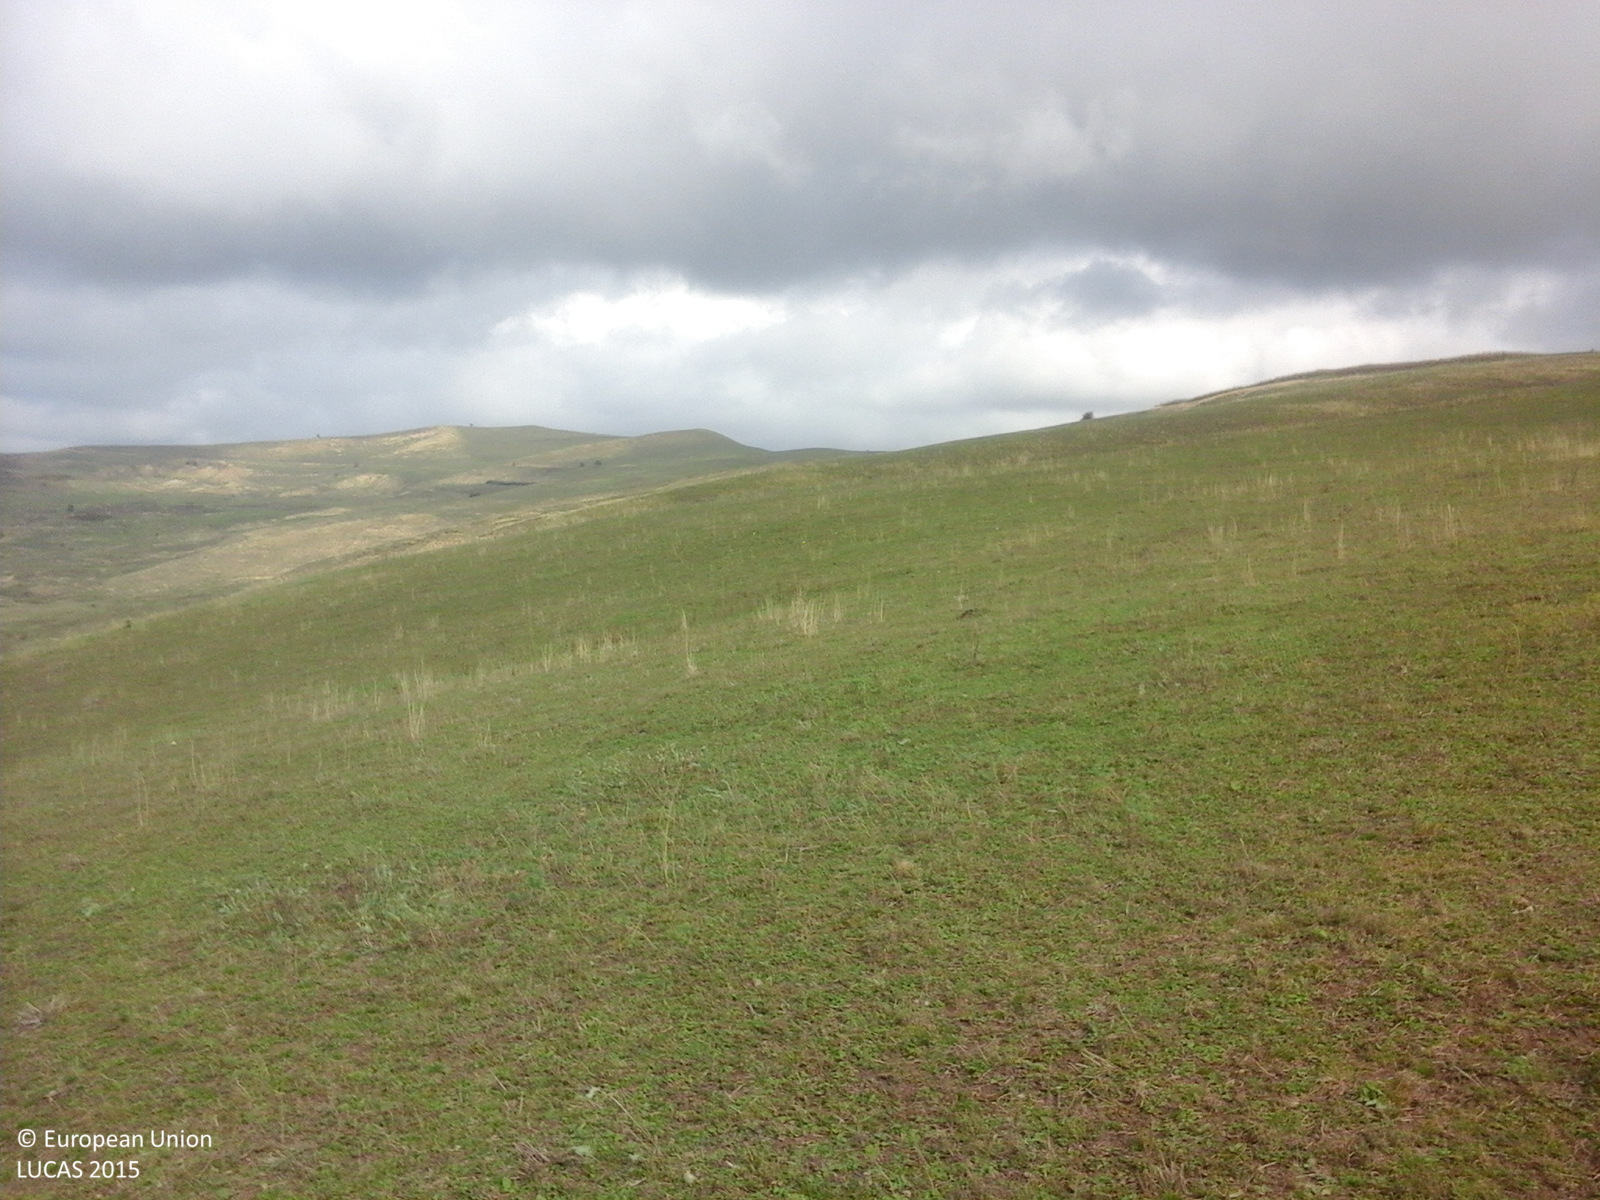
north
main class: Grassland
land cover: Grassland without tree/shrub cover
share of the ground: > 75 %
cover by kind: herbaceous plants 100 %
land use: Agriculture (excluding fallow land and kitchen gardens)
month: October
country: RO
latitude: 46.2657
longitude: 23.9971
